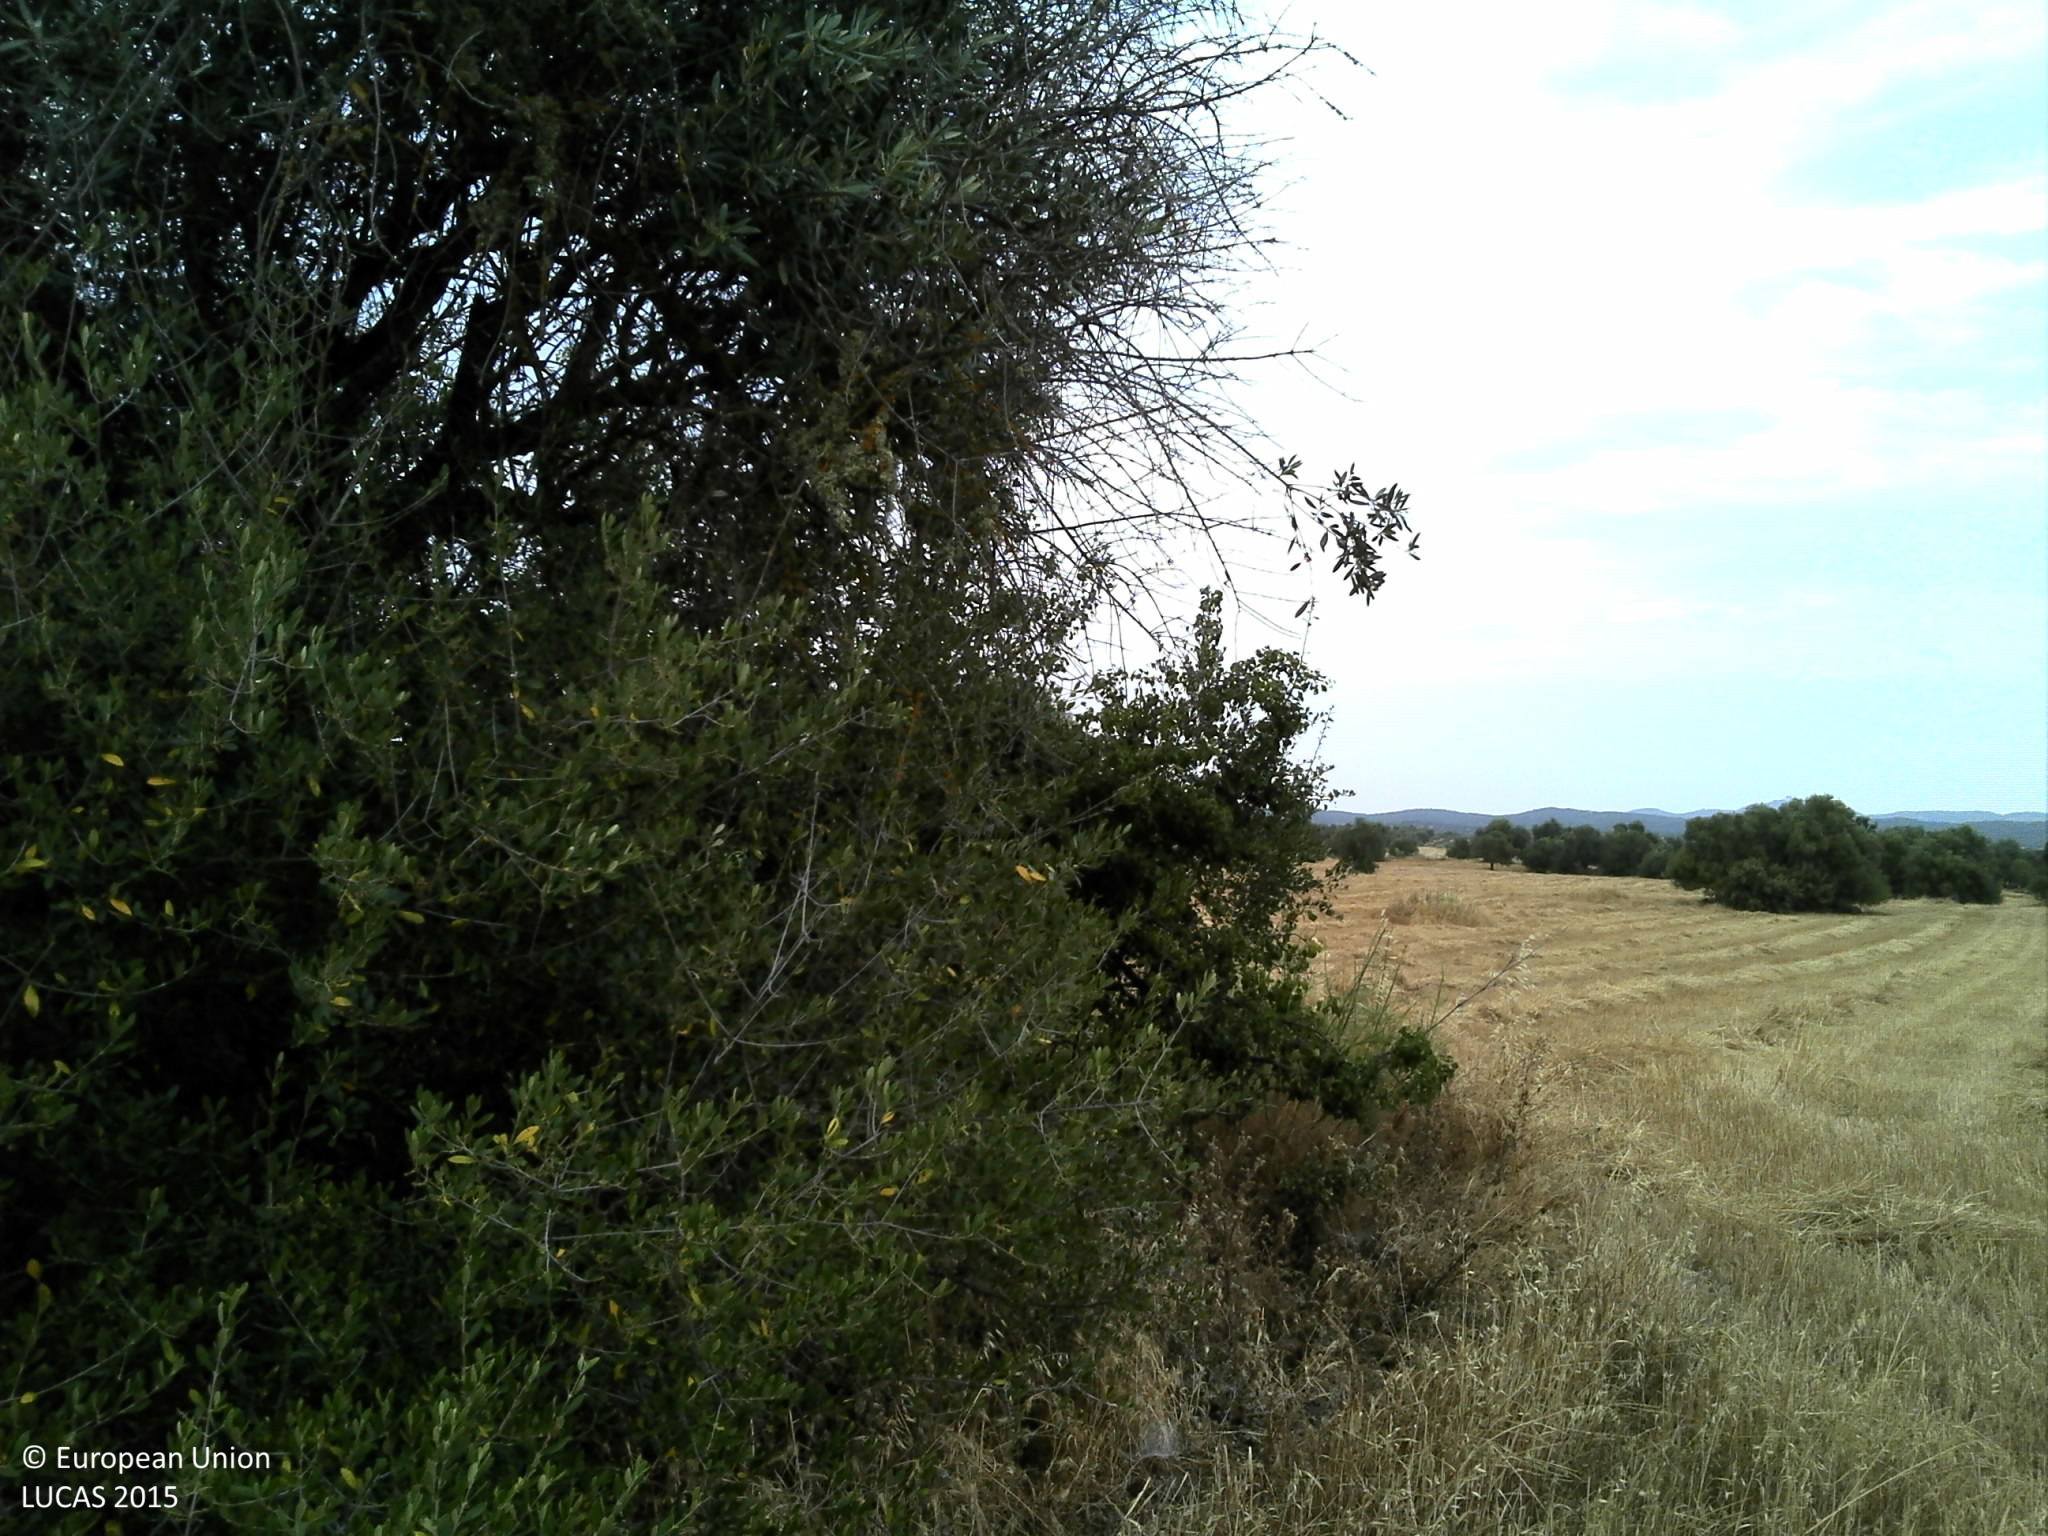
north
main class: Cropland
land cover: Olive groves
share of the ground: 10 - 25 %
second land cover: Mixed cereals for fodder
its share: < 10 %
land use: Agriculture (excluding fallow land and kitchen gardens)
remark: Harvested field
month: June
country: PT
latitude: 38.6670
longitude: -7.7717
